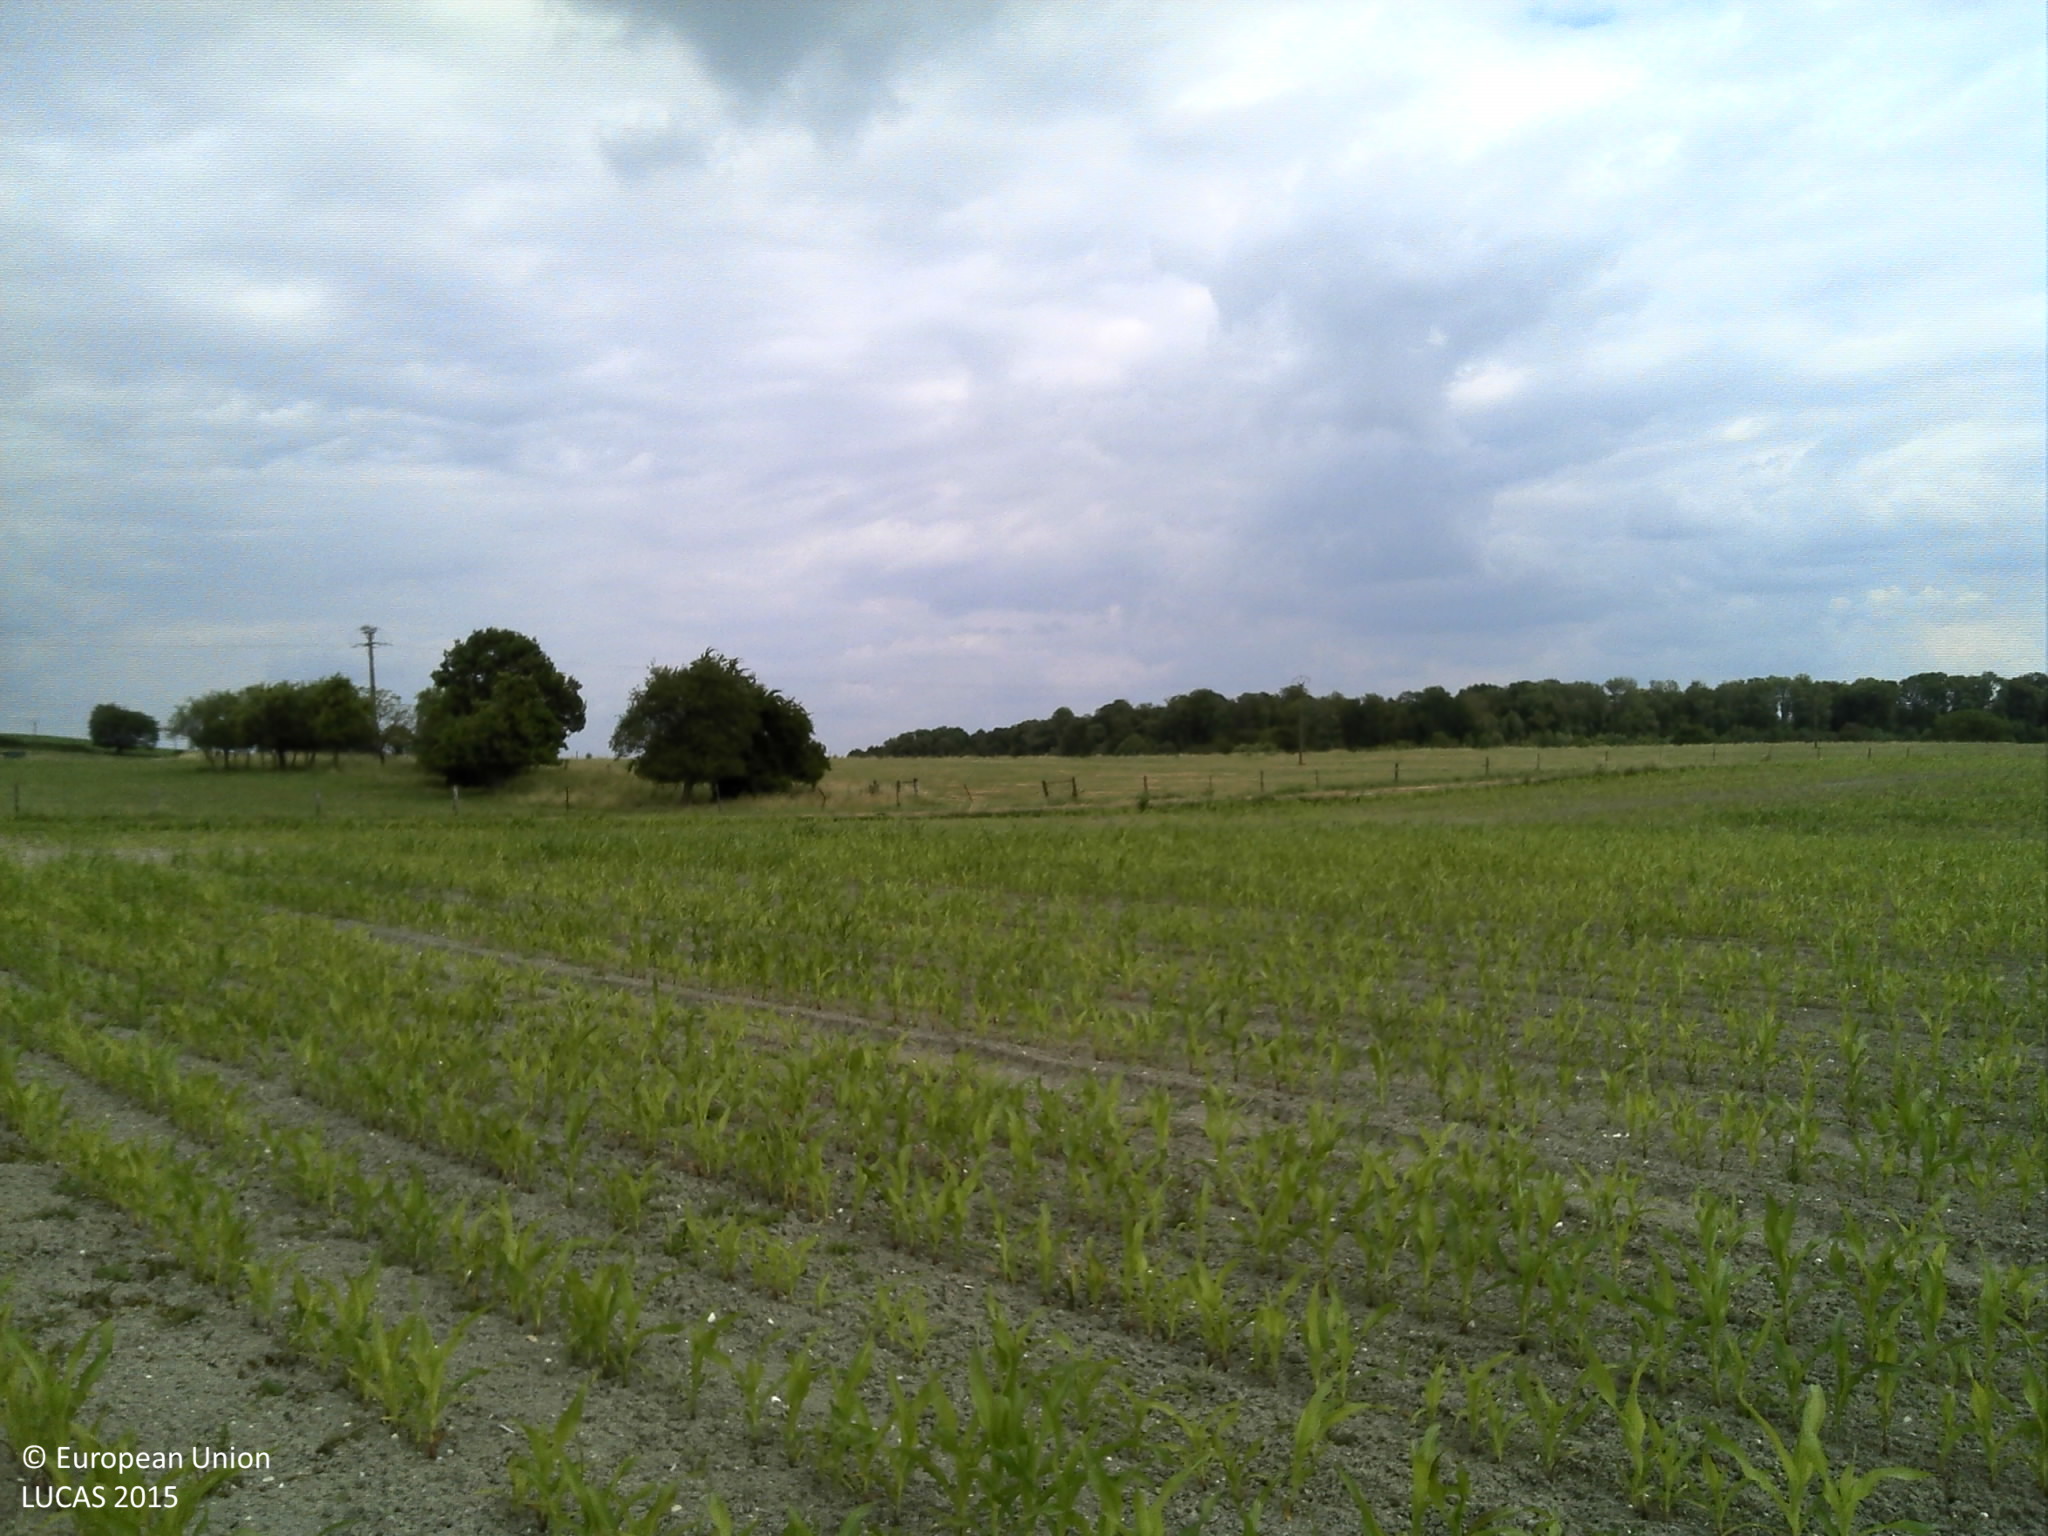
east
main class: Cropland
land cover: Maize
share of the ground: 25 - 50 %
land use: Agriculture (excluding fallow land and kitchen gardens)
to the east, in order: Maize; Grass margins; Tracks; Grass margins; Fences; Grassland without tree/shrub cover; Fences; Grassland without tree/shrub cover; Electric lines; Grassland without tree/shrub cover; Fences; Tracks
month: June
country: FR
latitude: 49.3477
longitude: 4.8629
